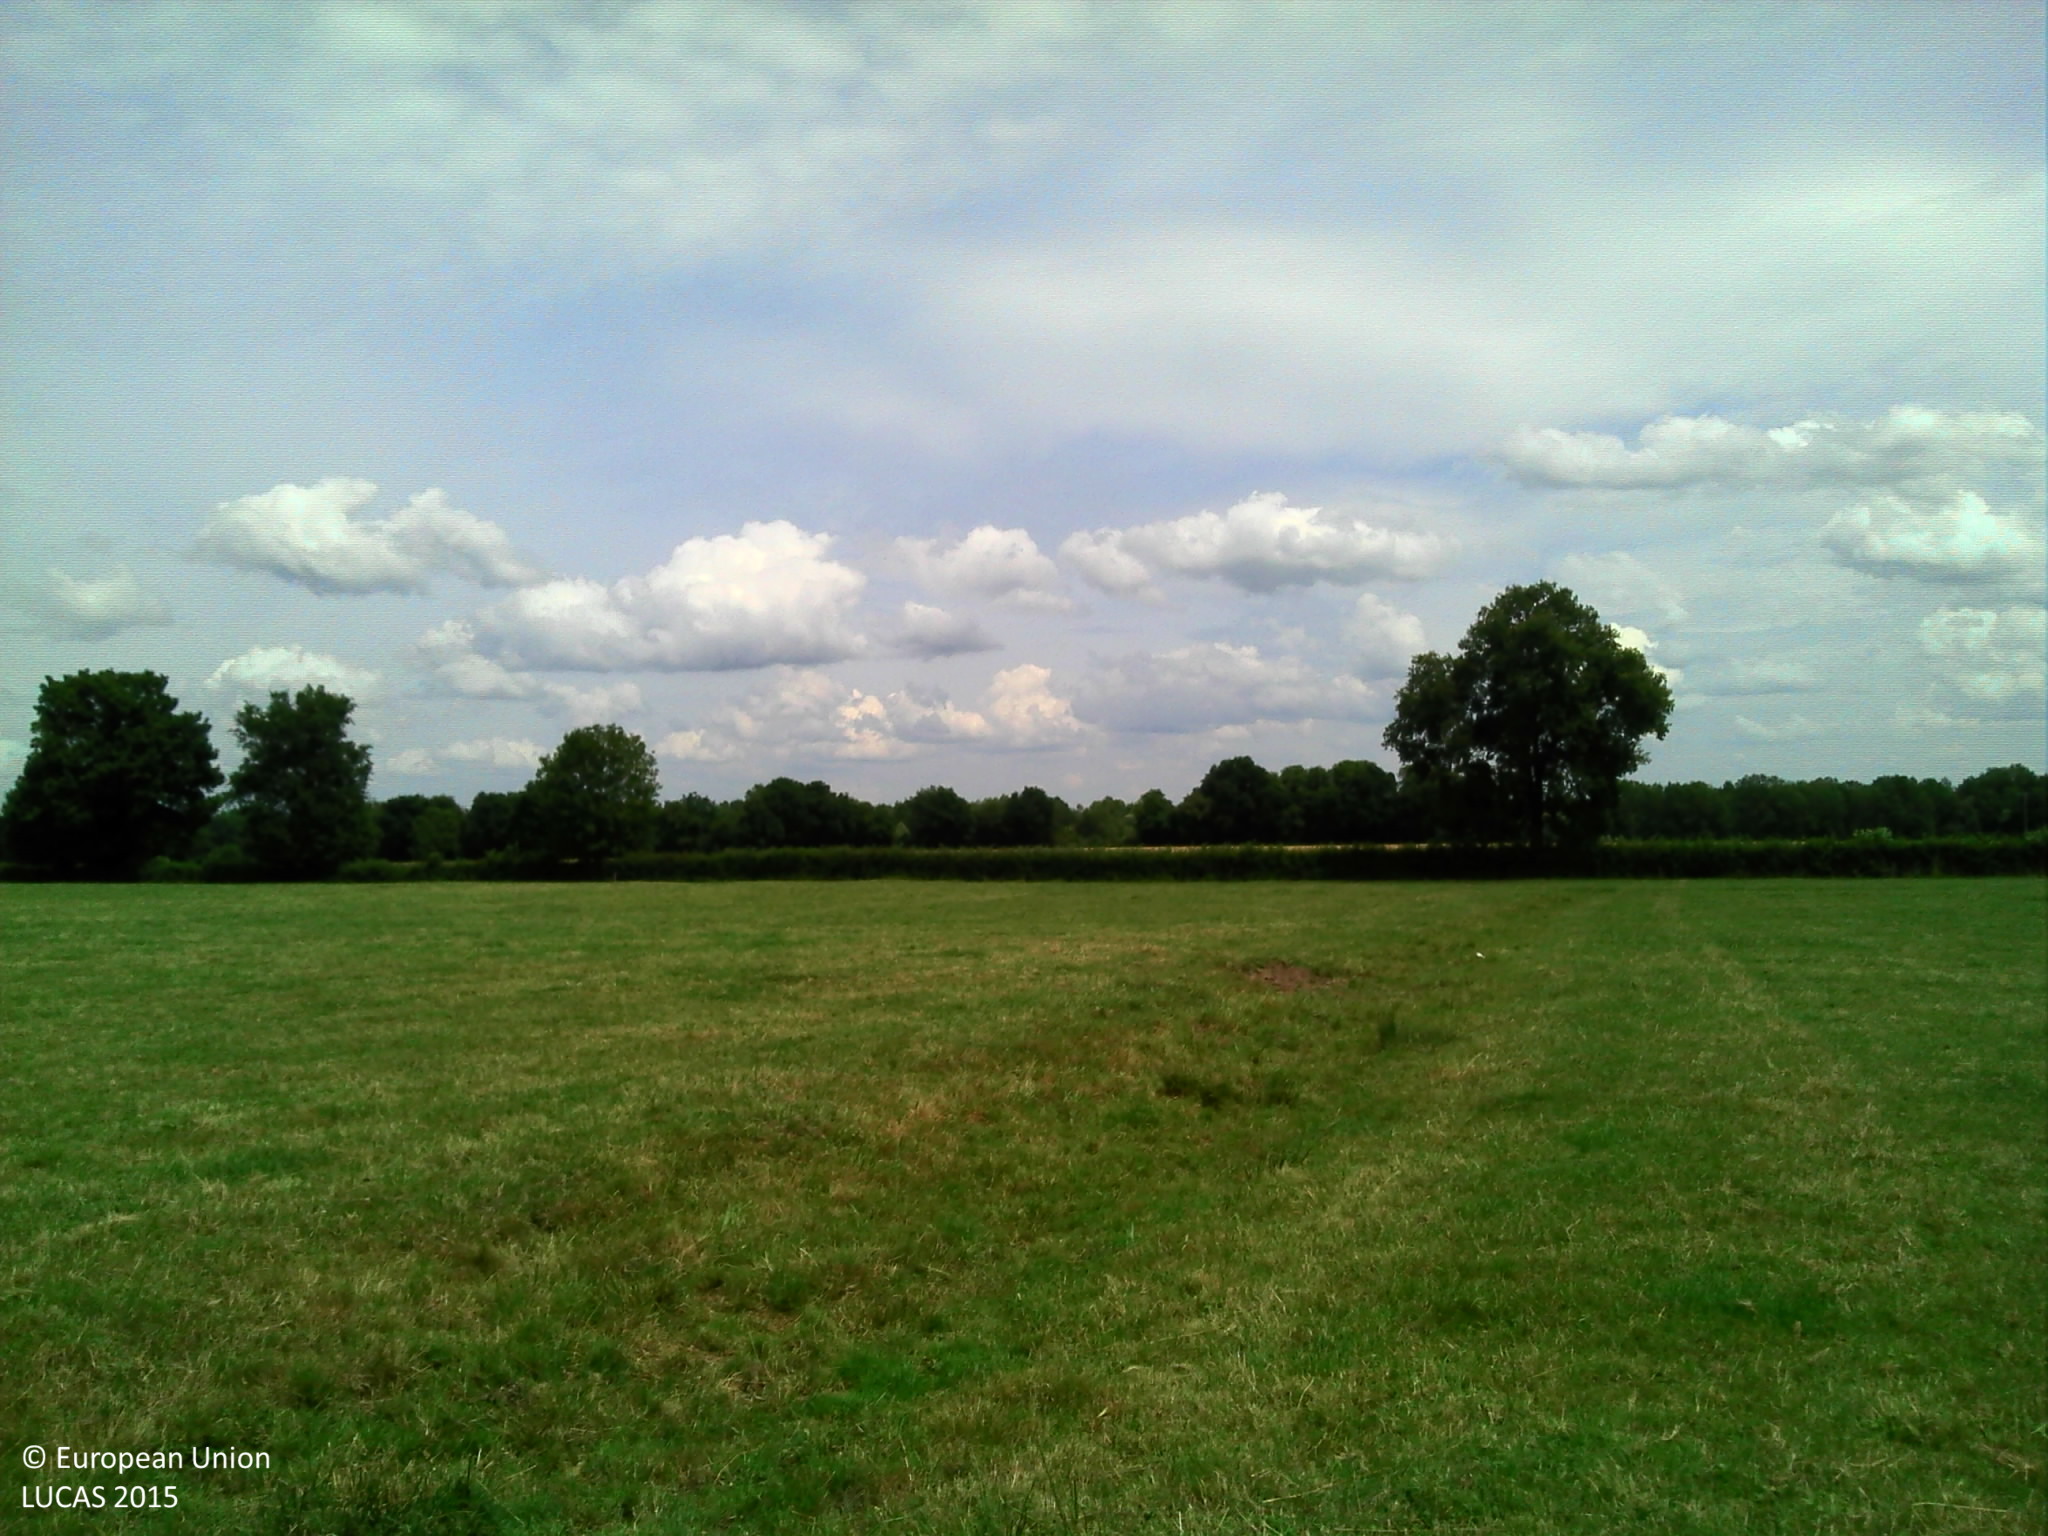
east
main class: Grassland
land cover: Grassland without tree/shrub cover
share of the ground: > 75 %
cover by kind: herbaceous plants 100 %
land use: Agriculture (excluding fallow land and kitchen gardens)
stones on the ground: < 10 %
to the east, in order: Grassland without tree/shrub cover; Fences; Abandoned hedges; Fences; Grassland without tree/shrub cover; Fences; Grassland without tree/shrub cover
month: June
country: FR
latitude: 46.4495
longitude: 3.3201
